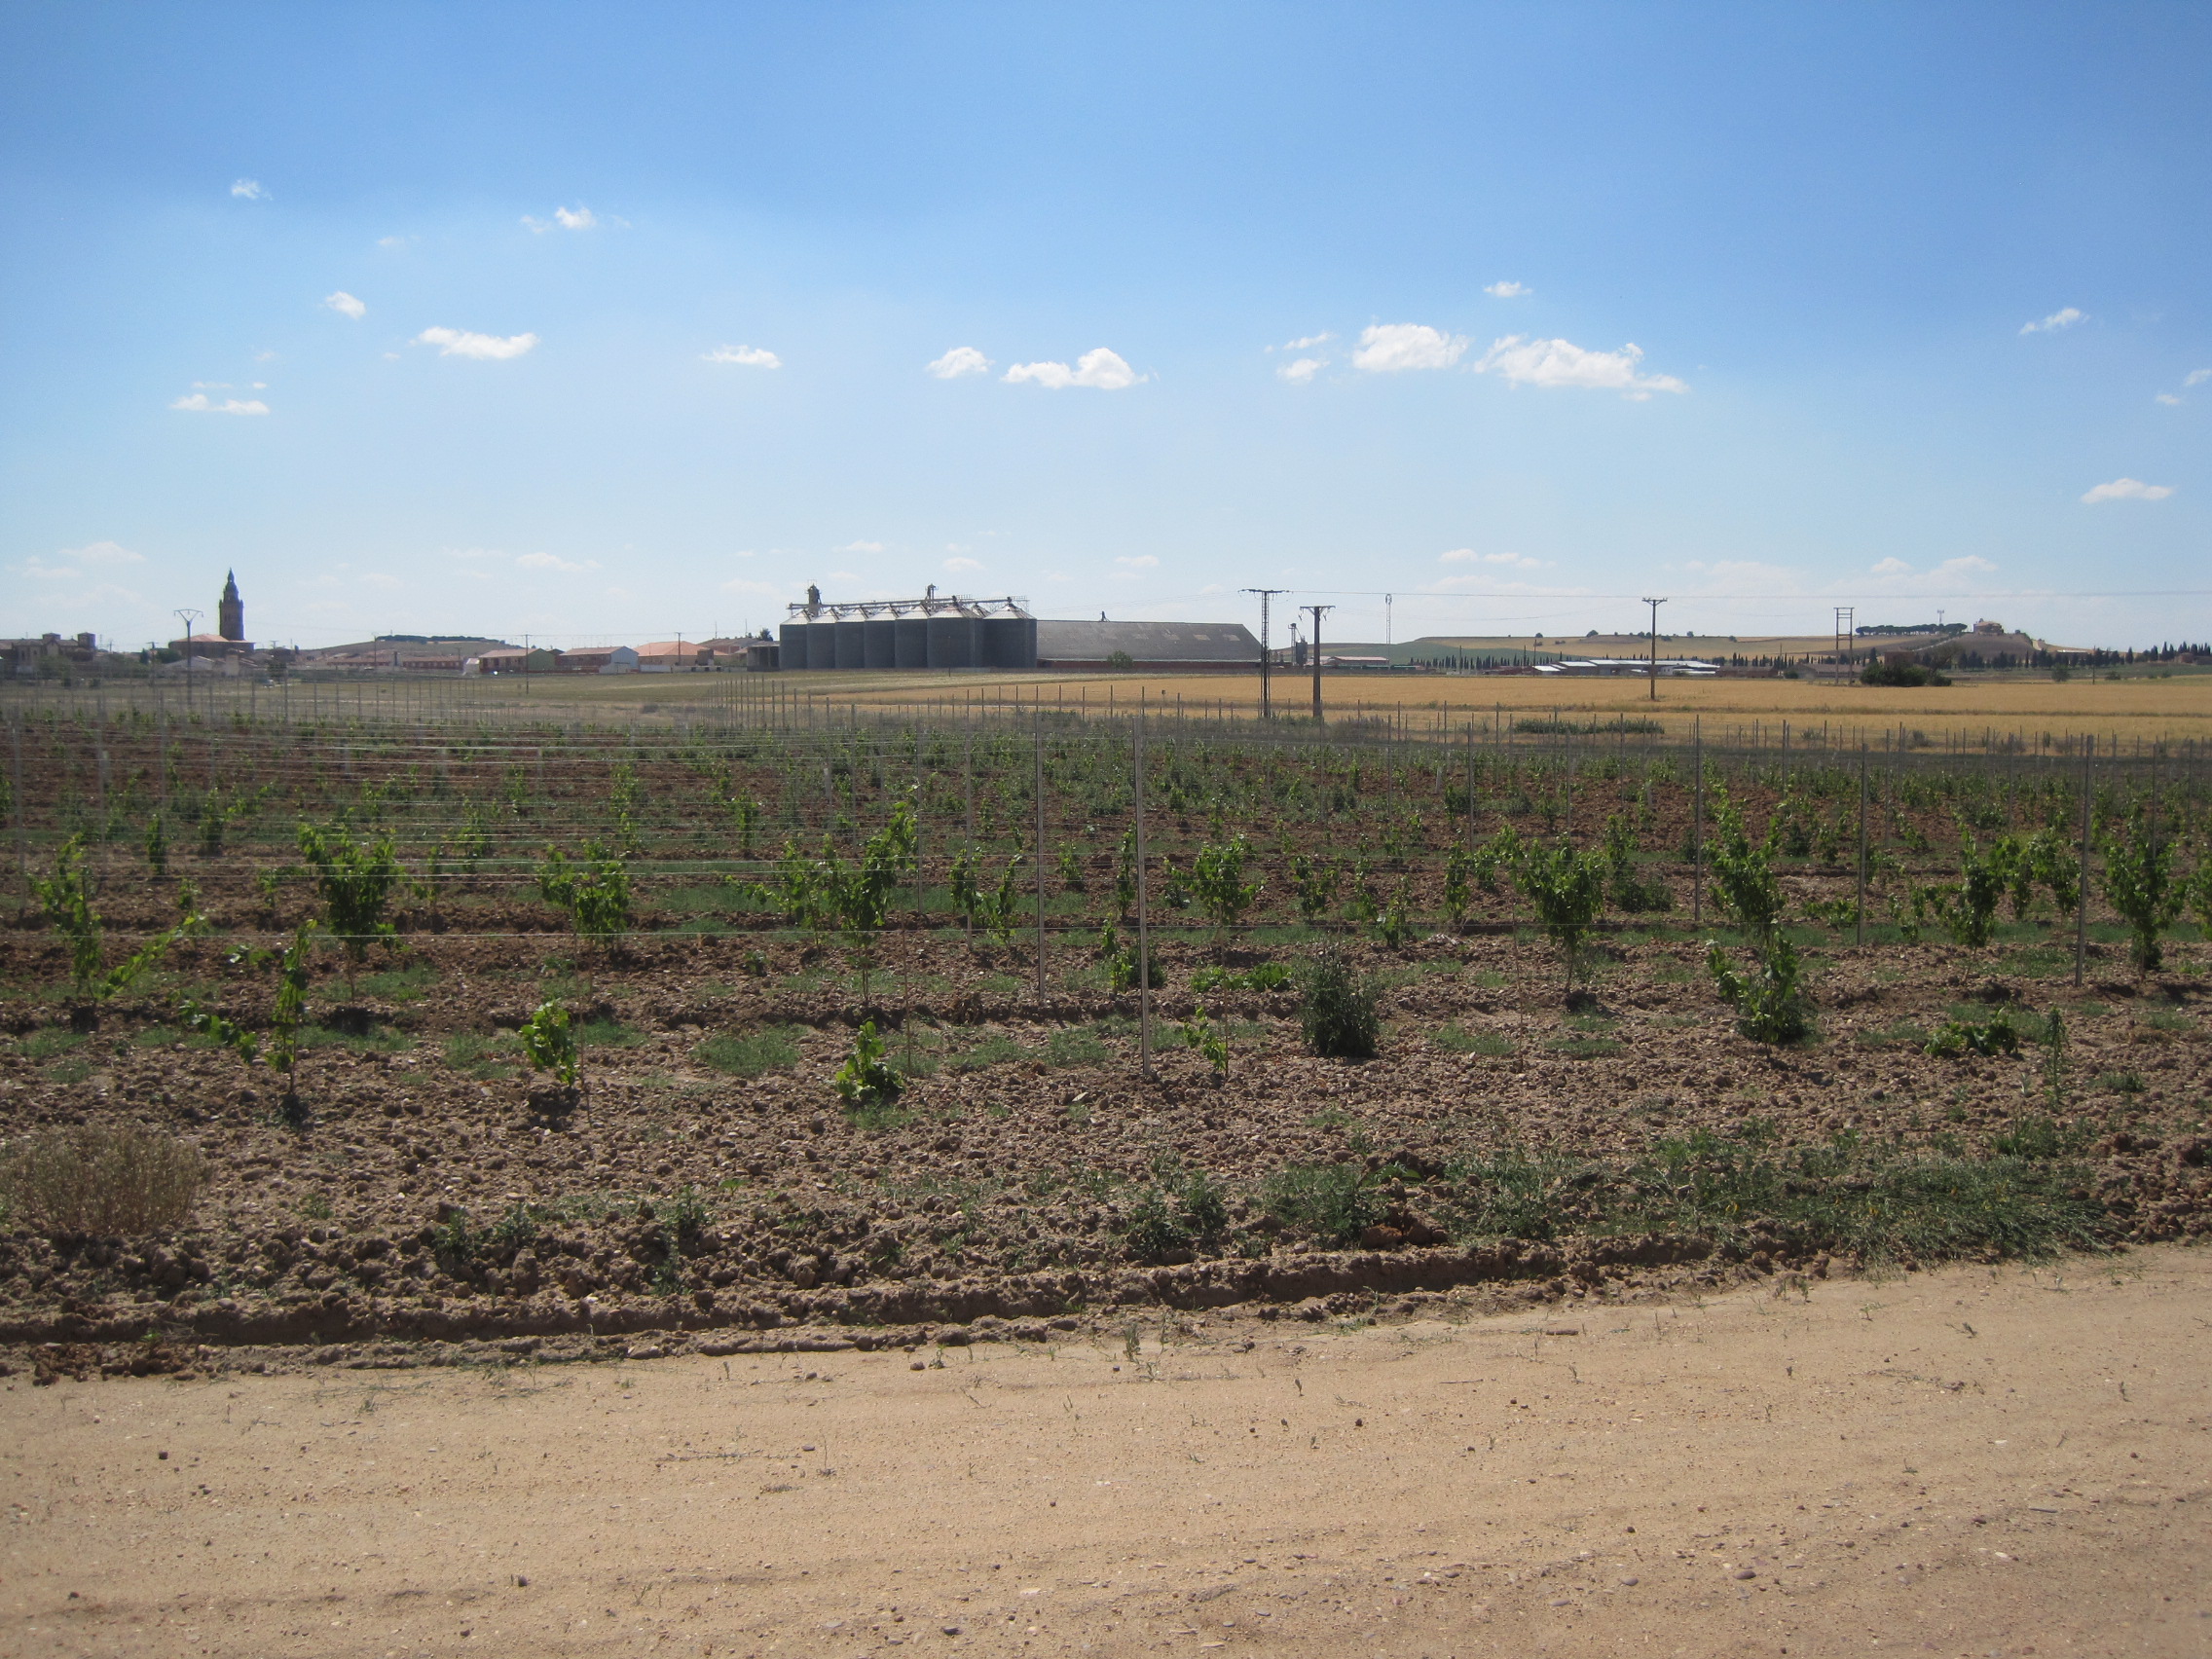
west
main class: Cropland
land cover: Vineyards
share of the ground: 25 - 50 %
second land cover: Other bare soil
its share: > 75 %
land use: Agriculture (excluding fallow land and kitchen gardens)
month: May
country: ES
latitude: 41.3360
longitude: -5.0676
